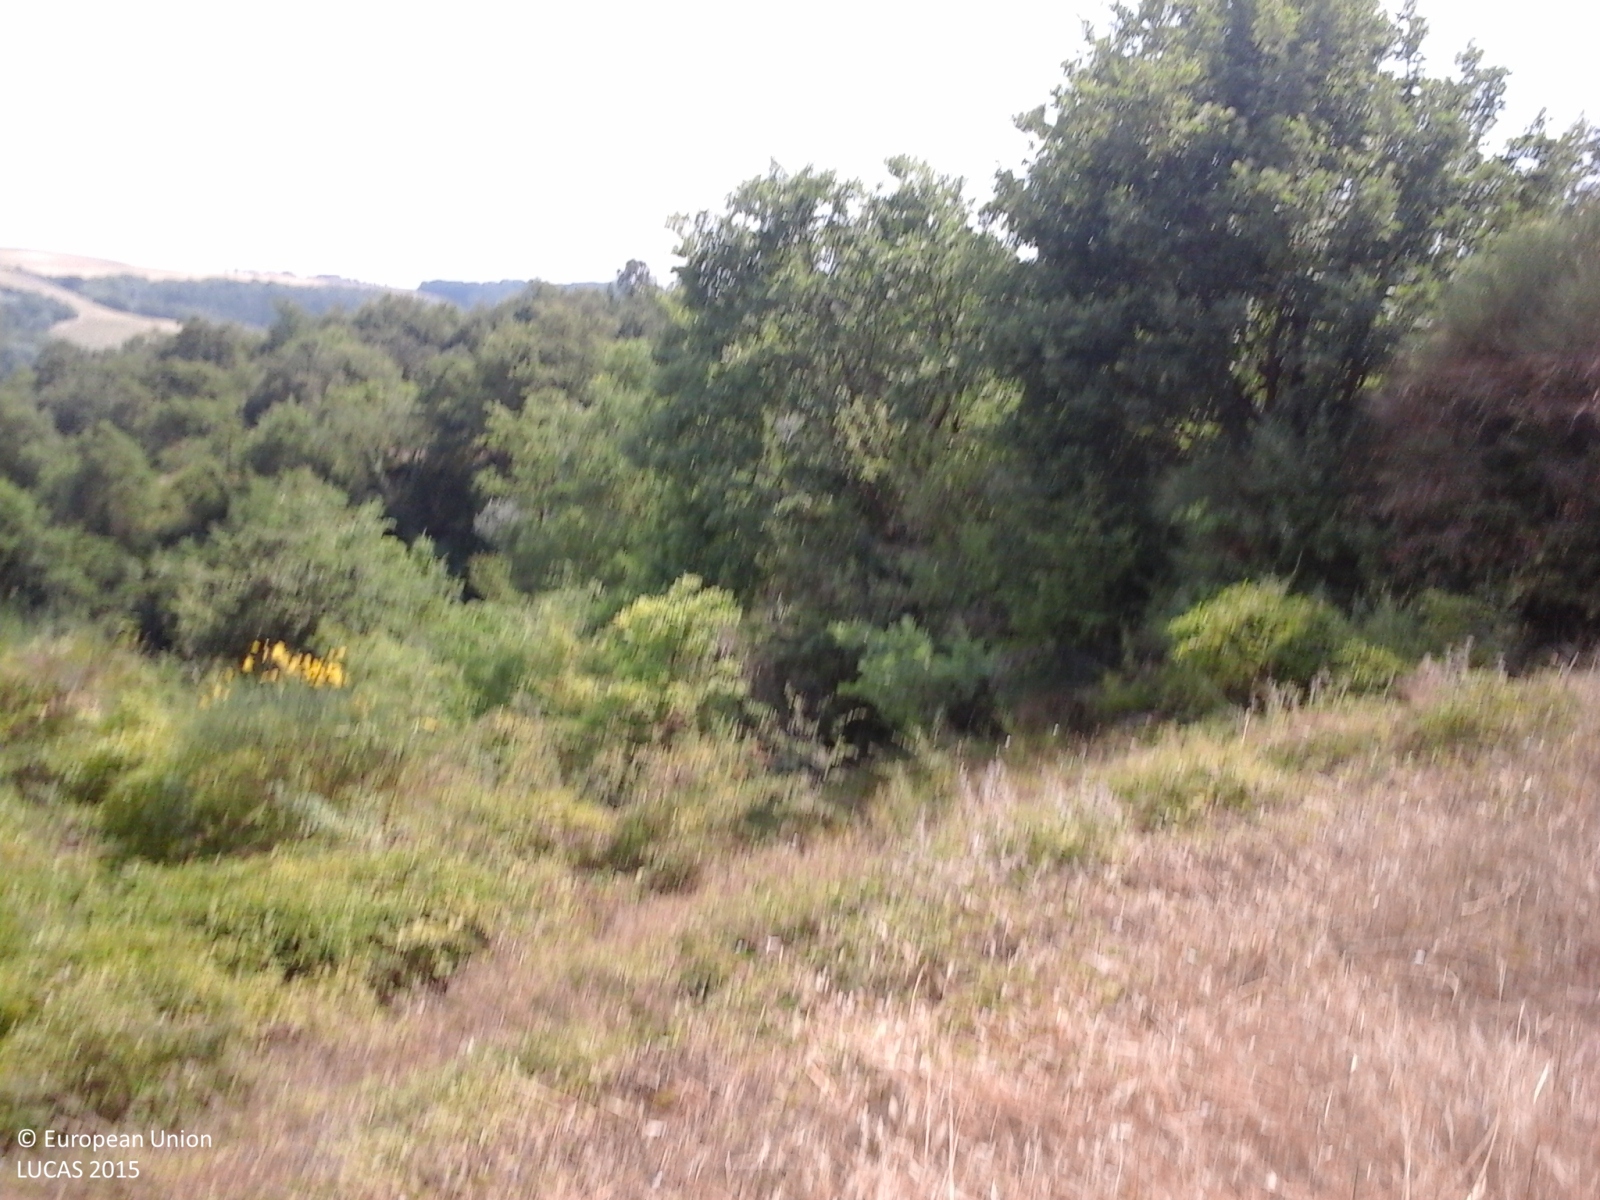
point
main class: Woodland
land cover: Broadleaved woodland
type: thermophilous deciduous forest
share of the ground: > 75 %
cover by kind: broadleaved forest trees 75 %, shrubs 20 %, herbaceous plants 5 %
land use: Semi-natural and natural areas not in use
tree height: > 5 m
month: July
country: IT
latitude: 43.1297
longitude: 11.5565
